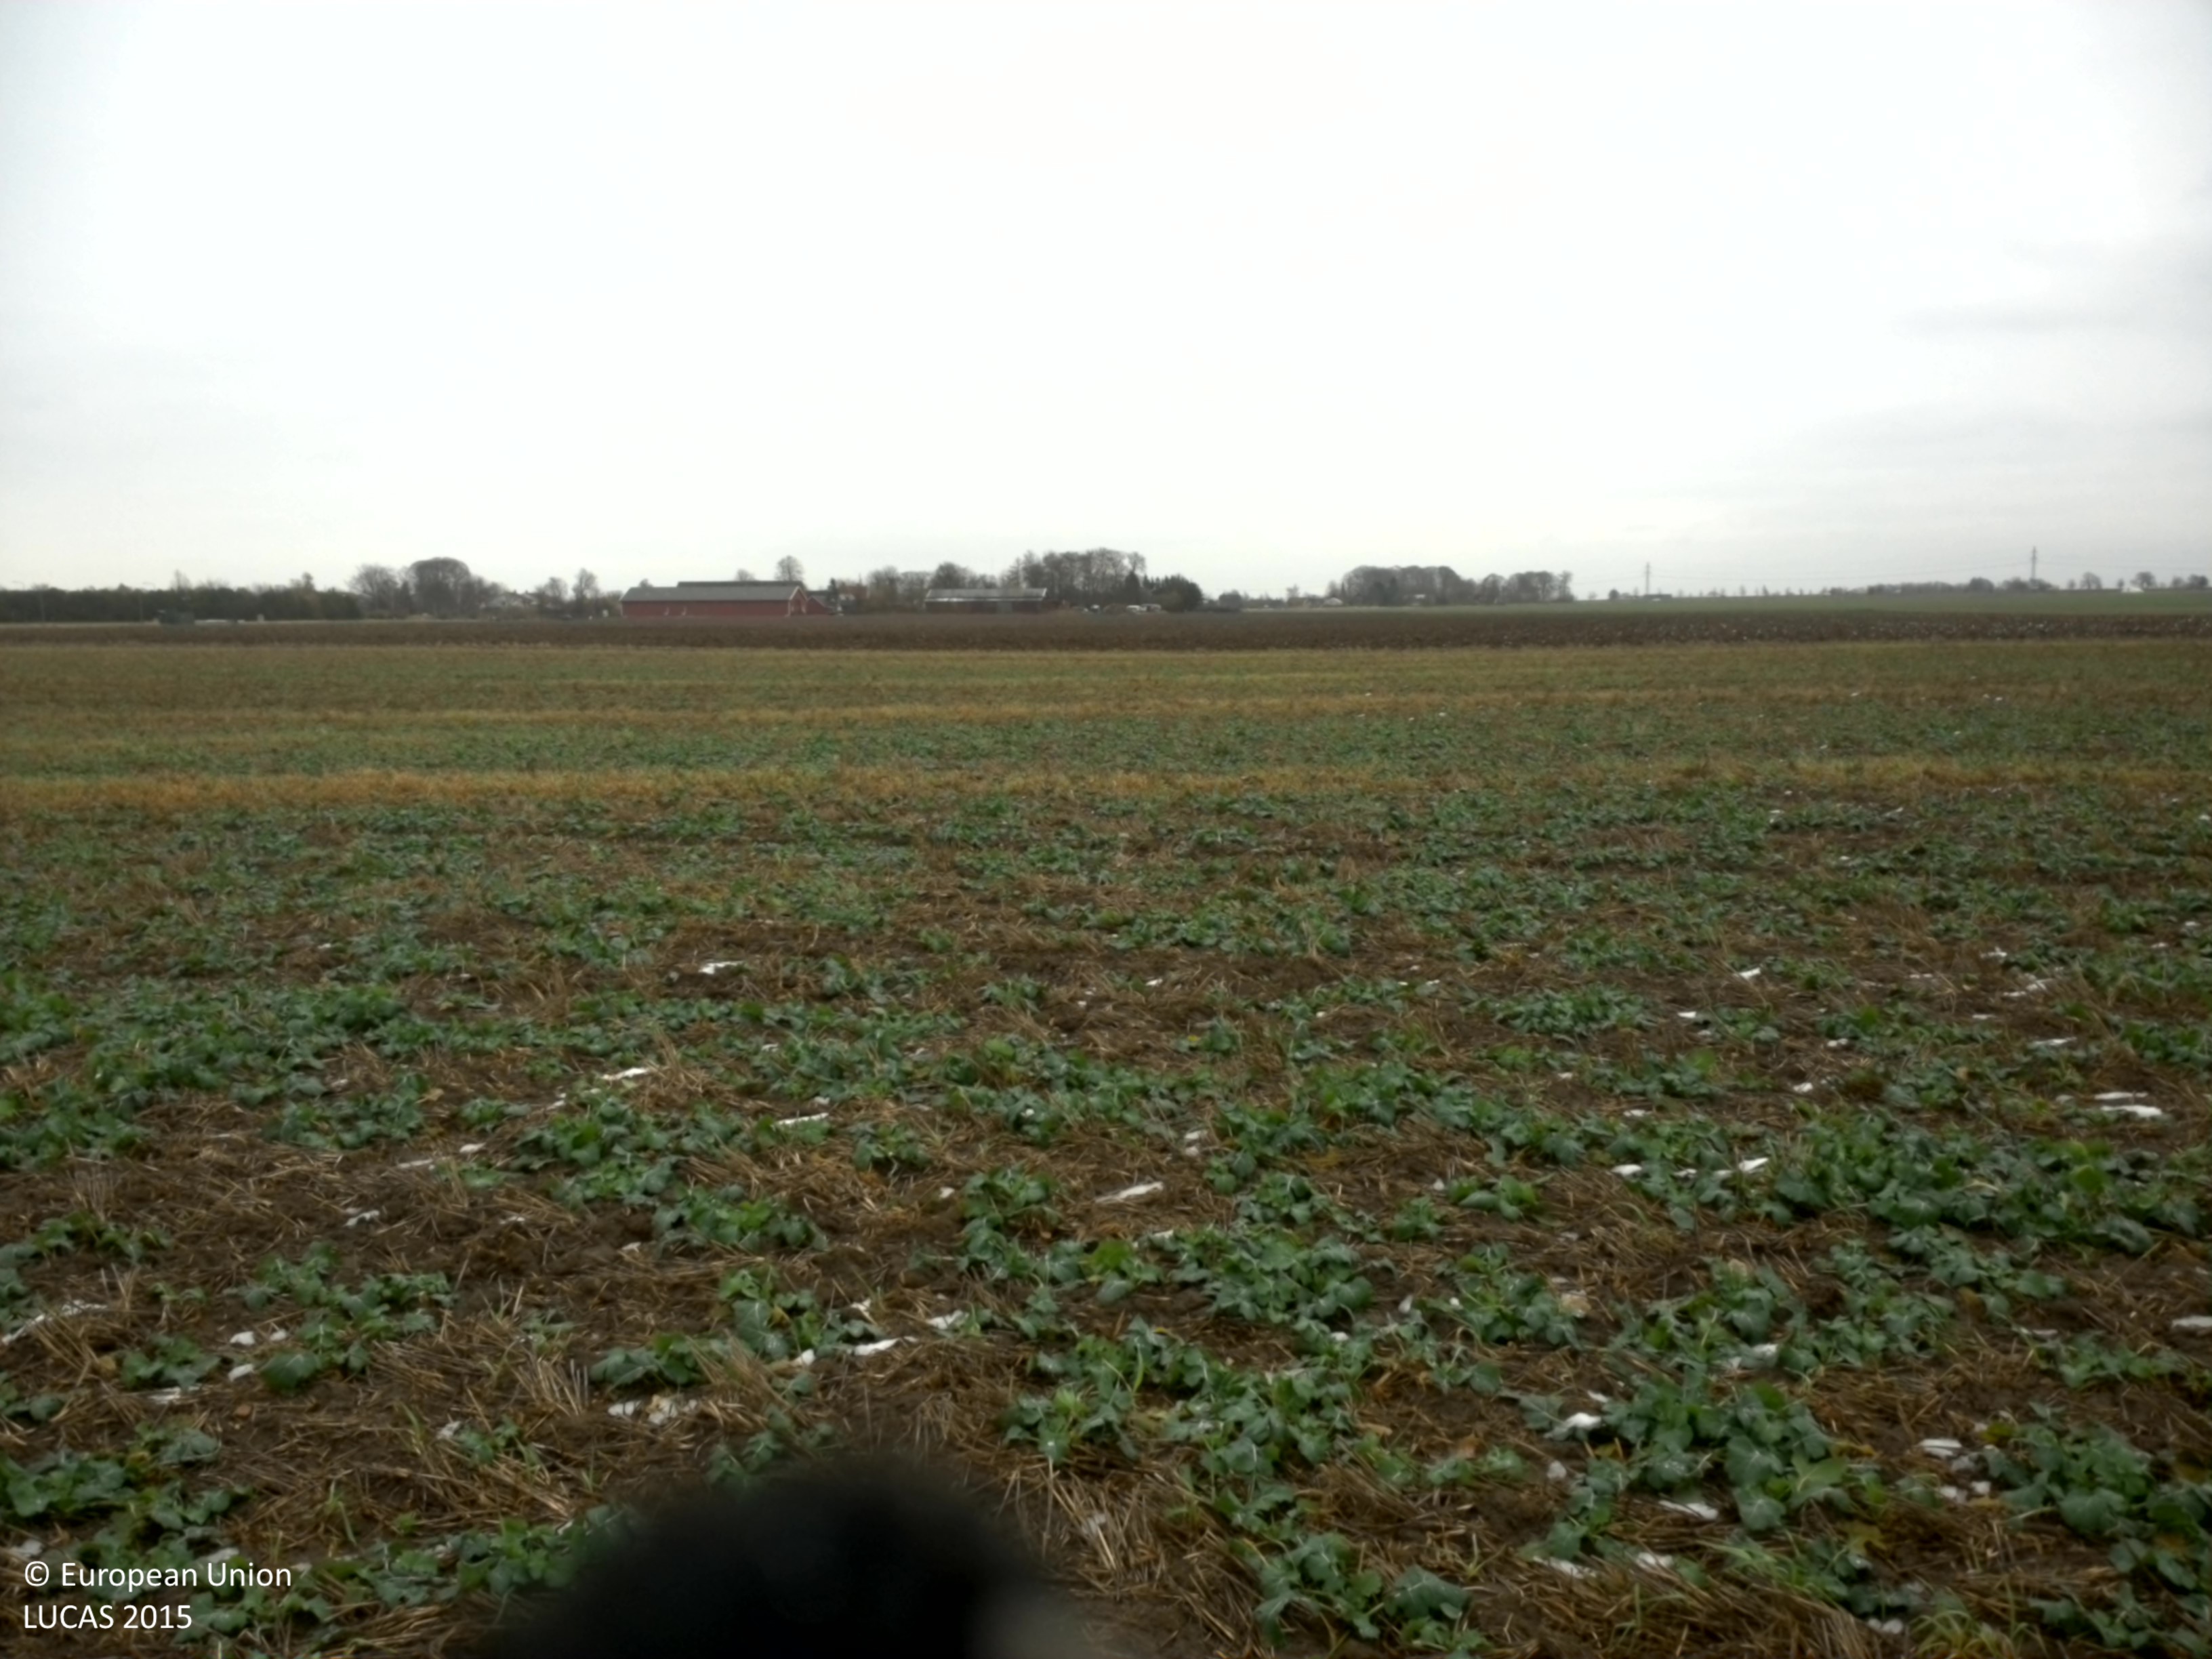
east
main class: Cropland
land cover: Rape and turnip rape
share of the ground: 25 - 50 %
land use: Agriculture (excluding fallow land and kitchen gardens)
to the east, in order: Rape and turnip rape; Other bare soil
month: November
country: SE
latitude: 55.6639
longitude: 13.1296
